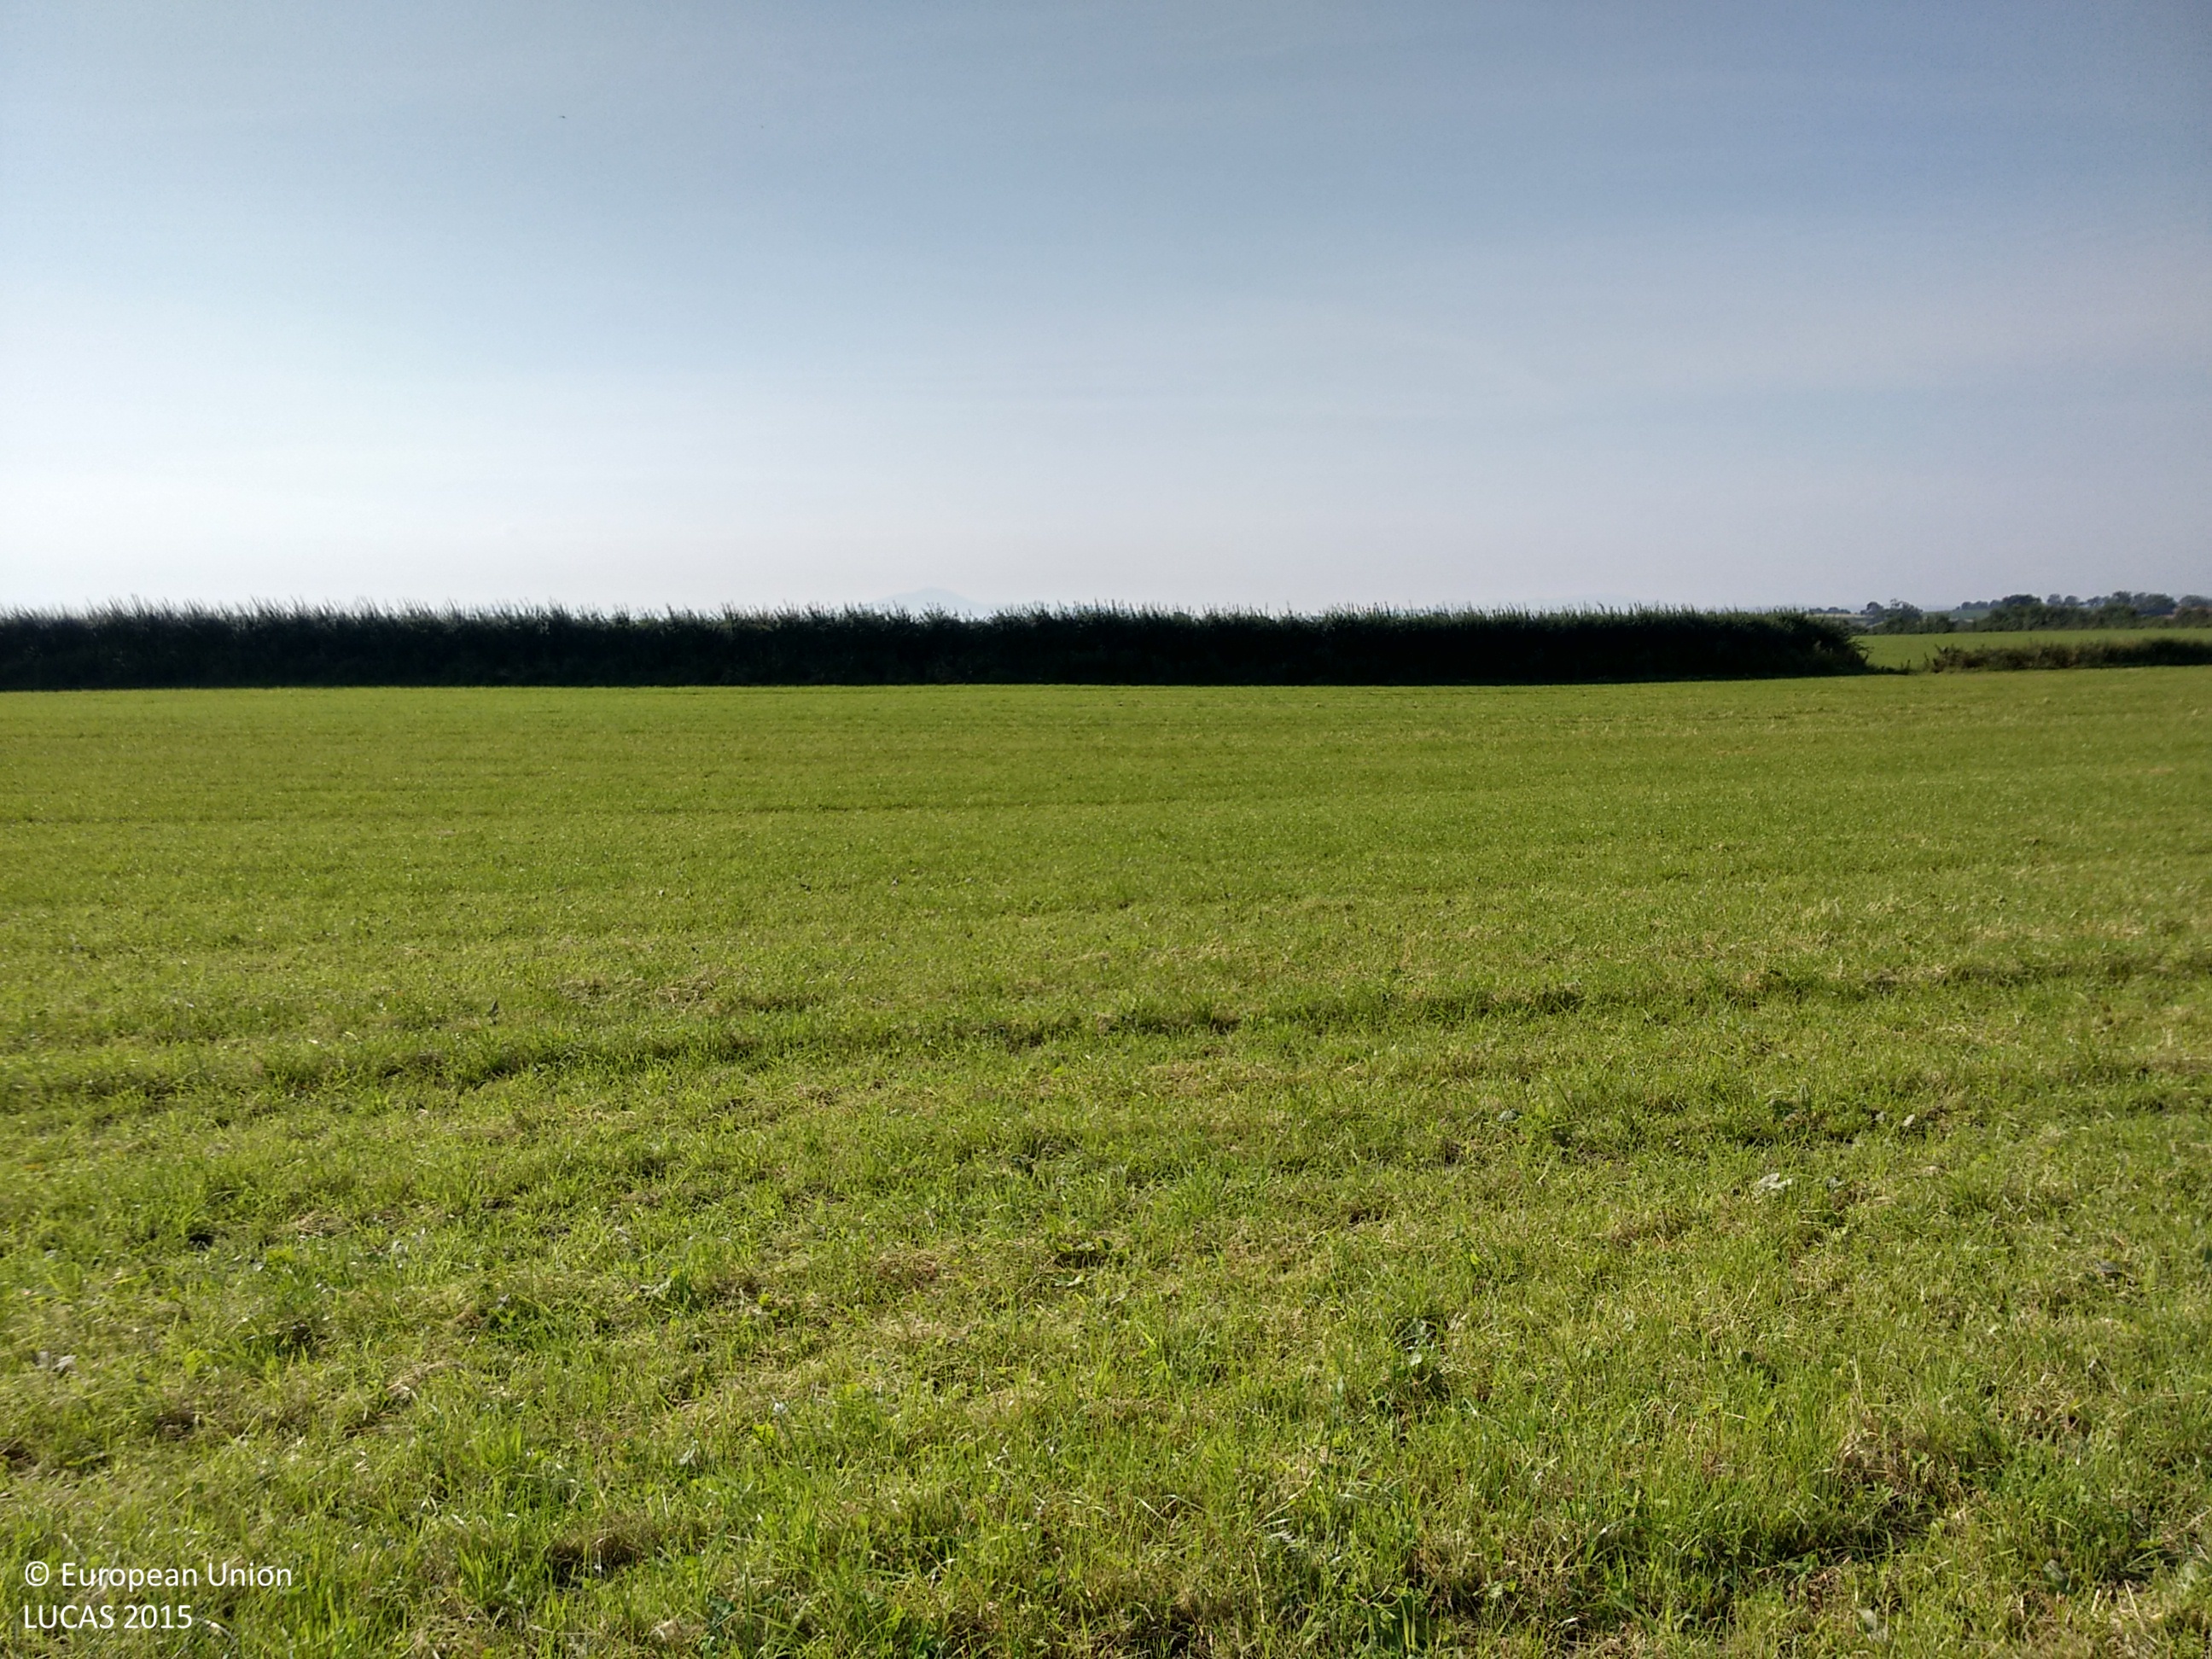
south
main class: Cropland
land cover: Temporary grasslands
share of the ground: > 75 %
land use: Agriculture (excluding fallow land and kitchen gardens)
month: August
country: GB
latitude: 54.8382
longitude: -3.2646
